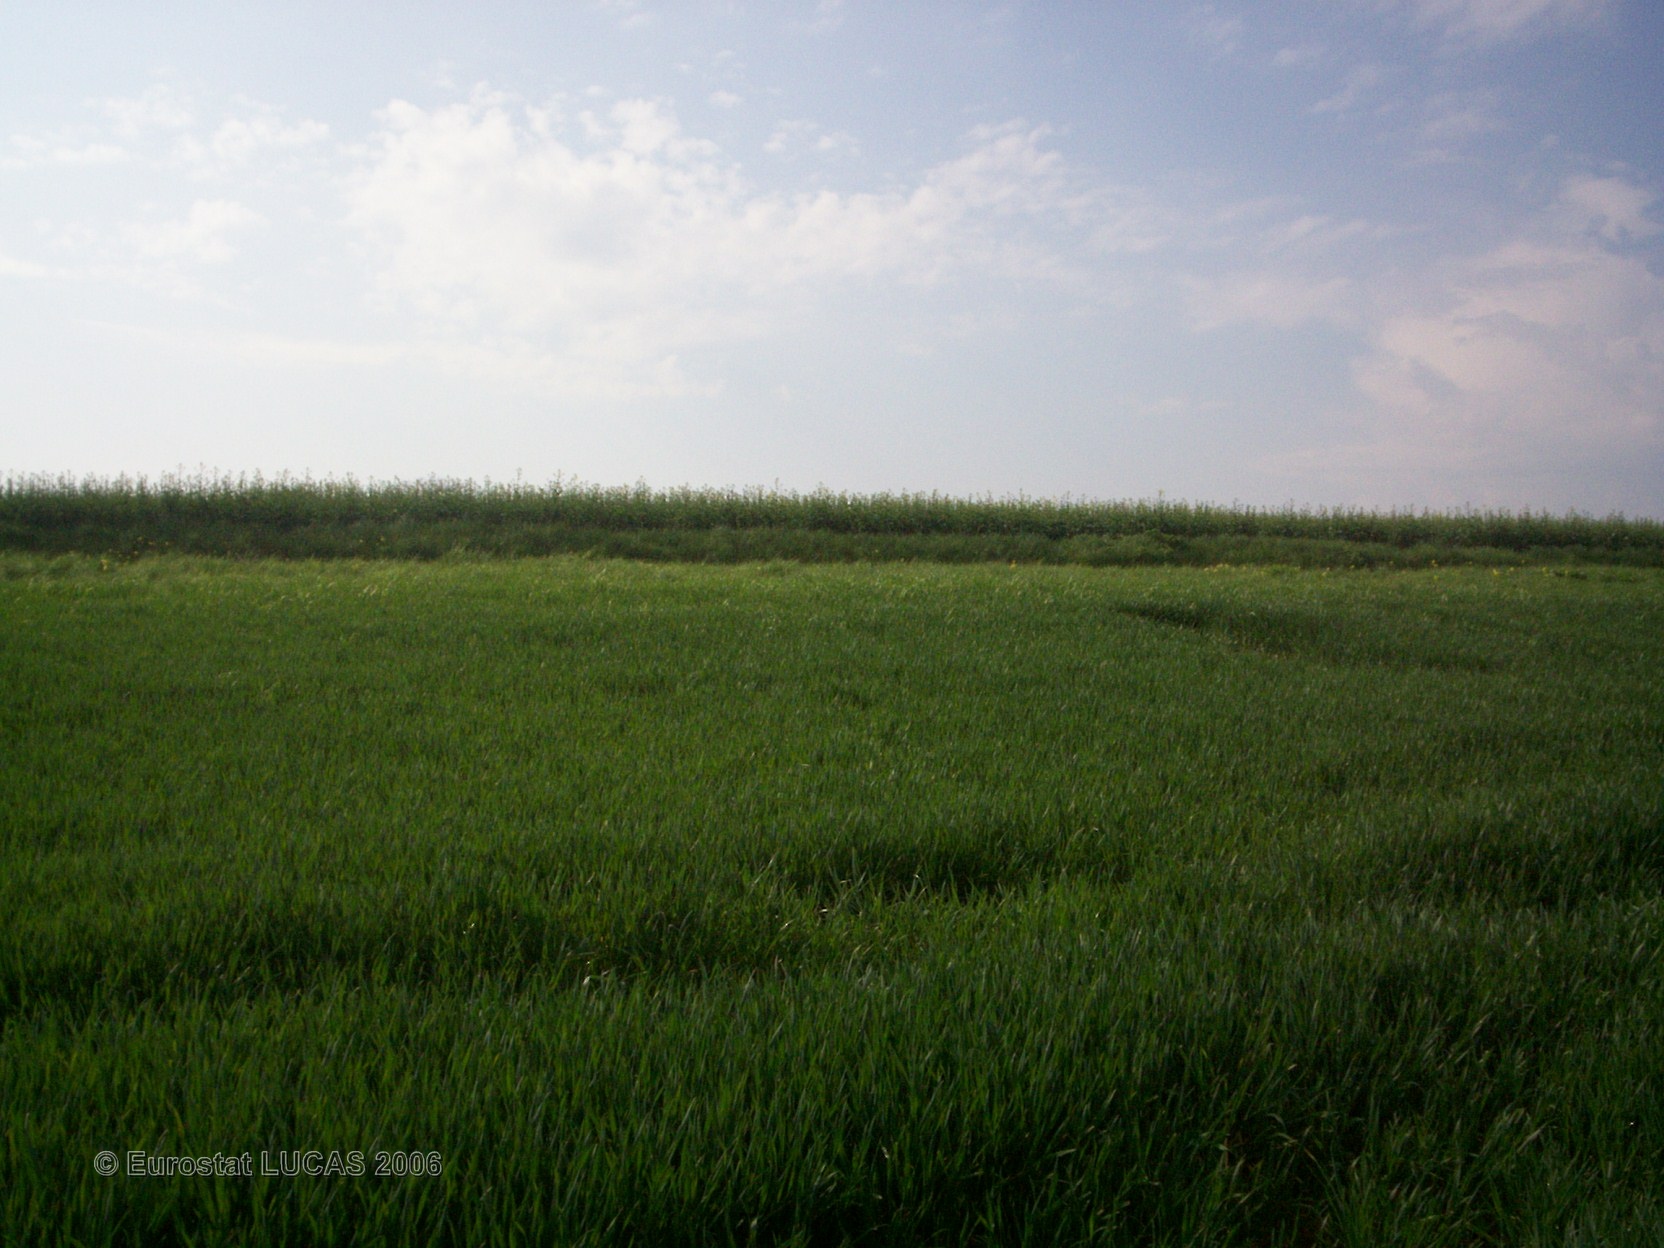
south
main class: Cropland
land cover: Common wheat
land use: Agriculture (excluding fallow land and kitchen gardens)
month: April
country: FR
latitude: 47.4055
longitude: 3.0110
